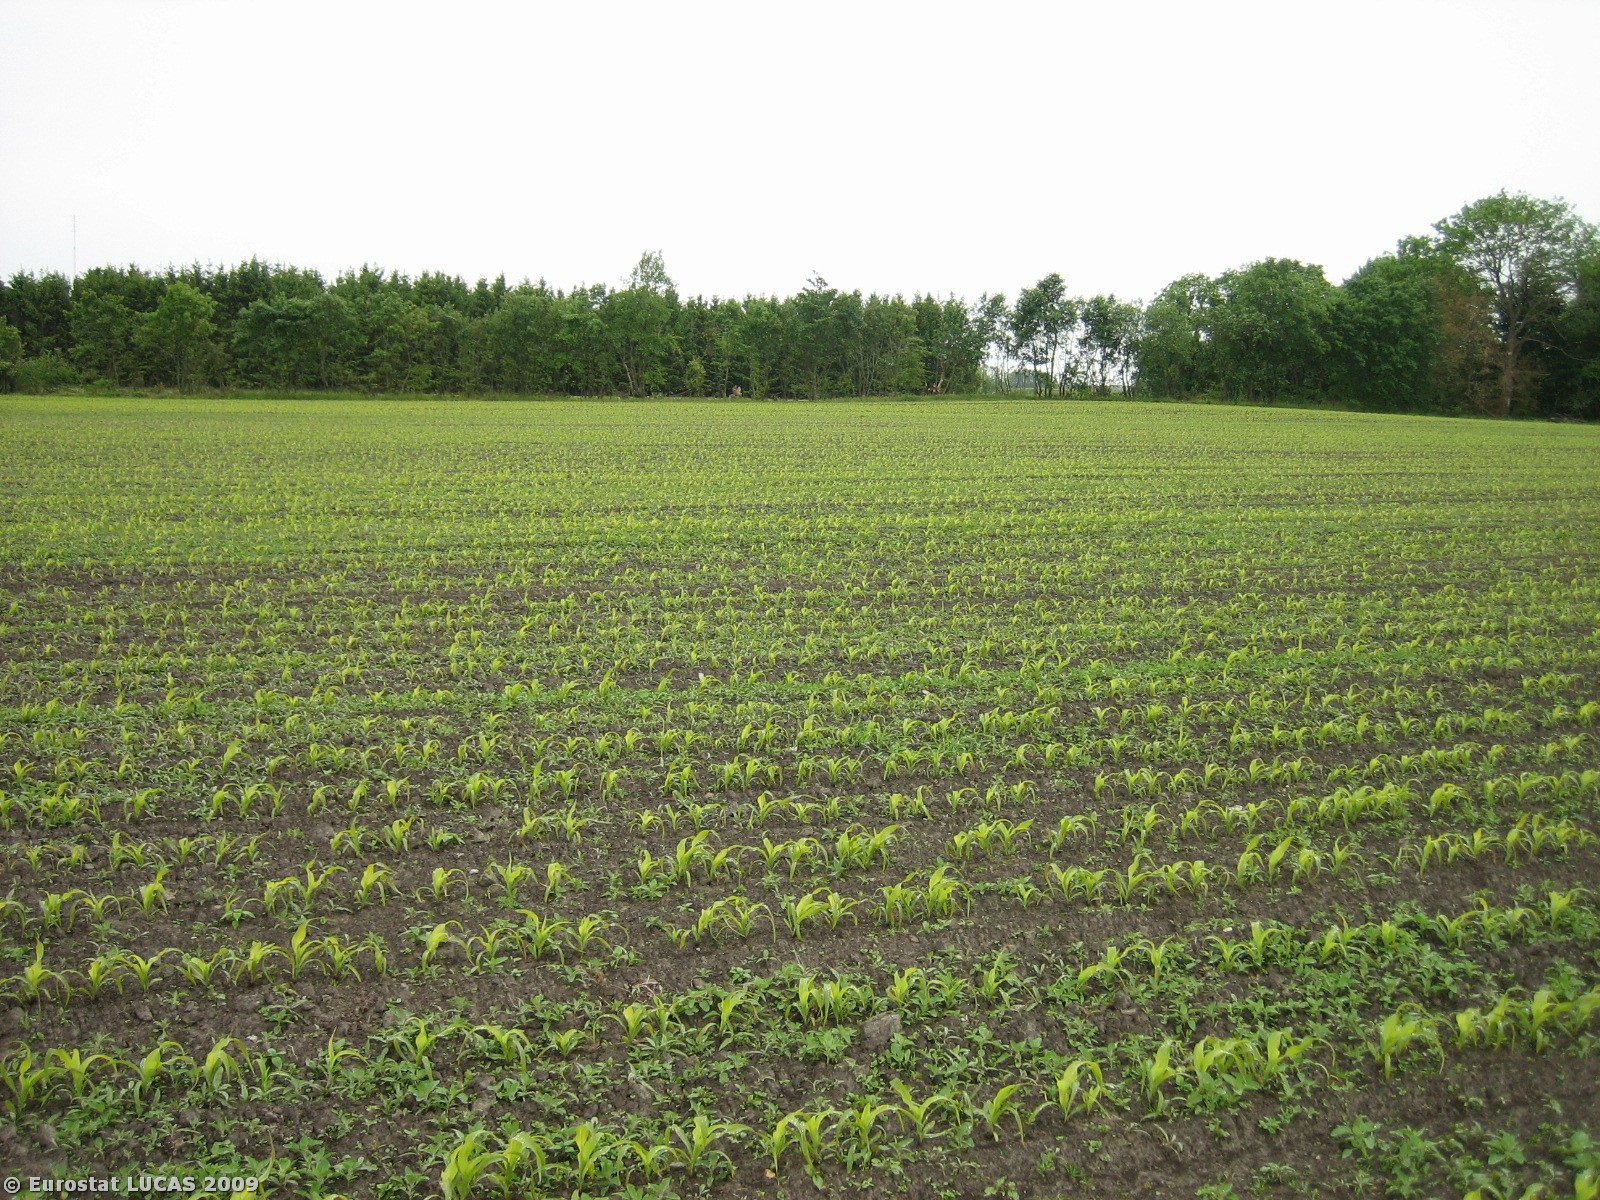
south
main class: Cropland
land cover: Maize
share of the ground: < 10 %
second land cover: Spontaneously vegetated surfaces
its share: 10 - 25 %
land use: Agriculture (excluding fallow land and kitchen gardens)
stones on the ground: < 10 %
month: June
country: DK
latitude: 56.2416
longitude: 10.1128
